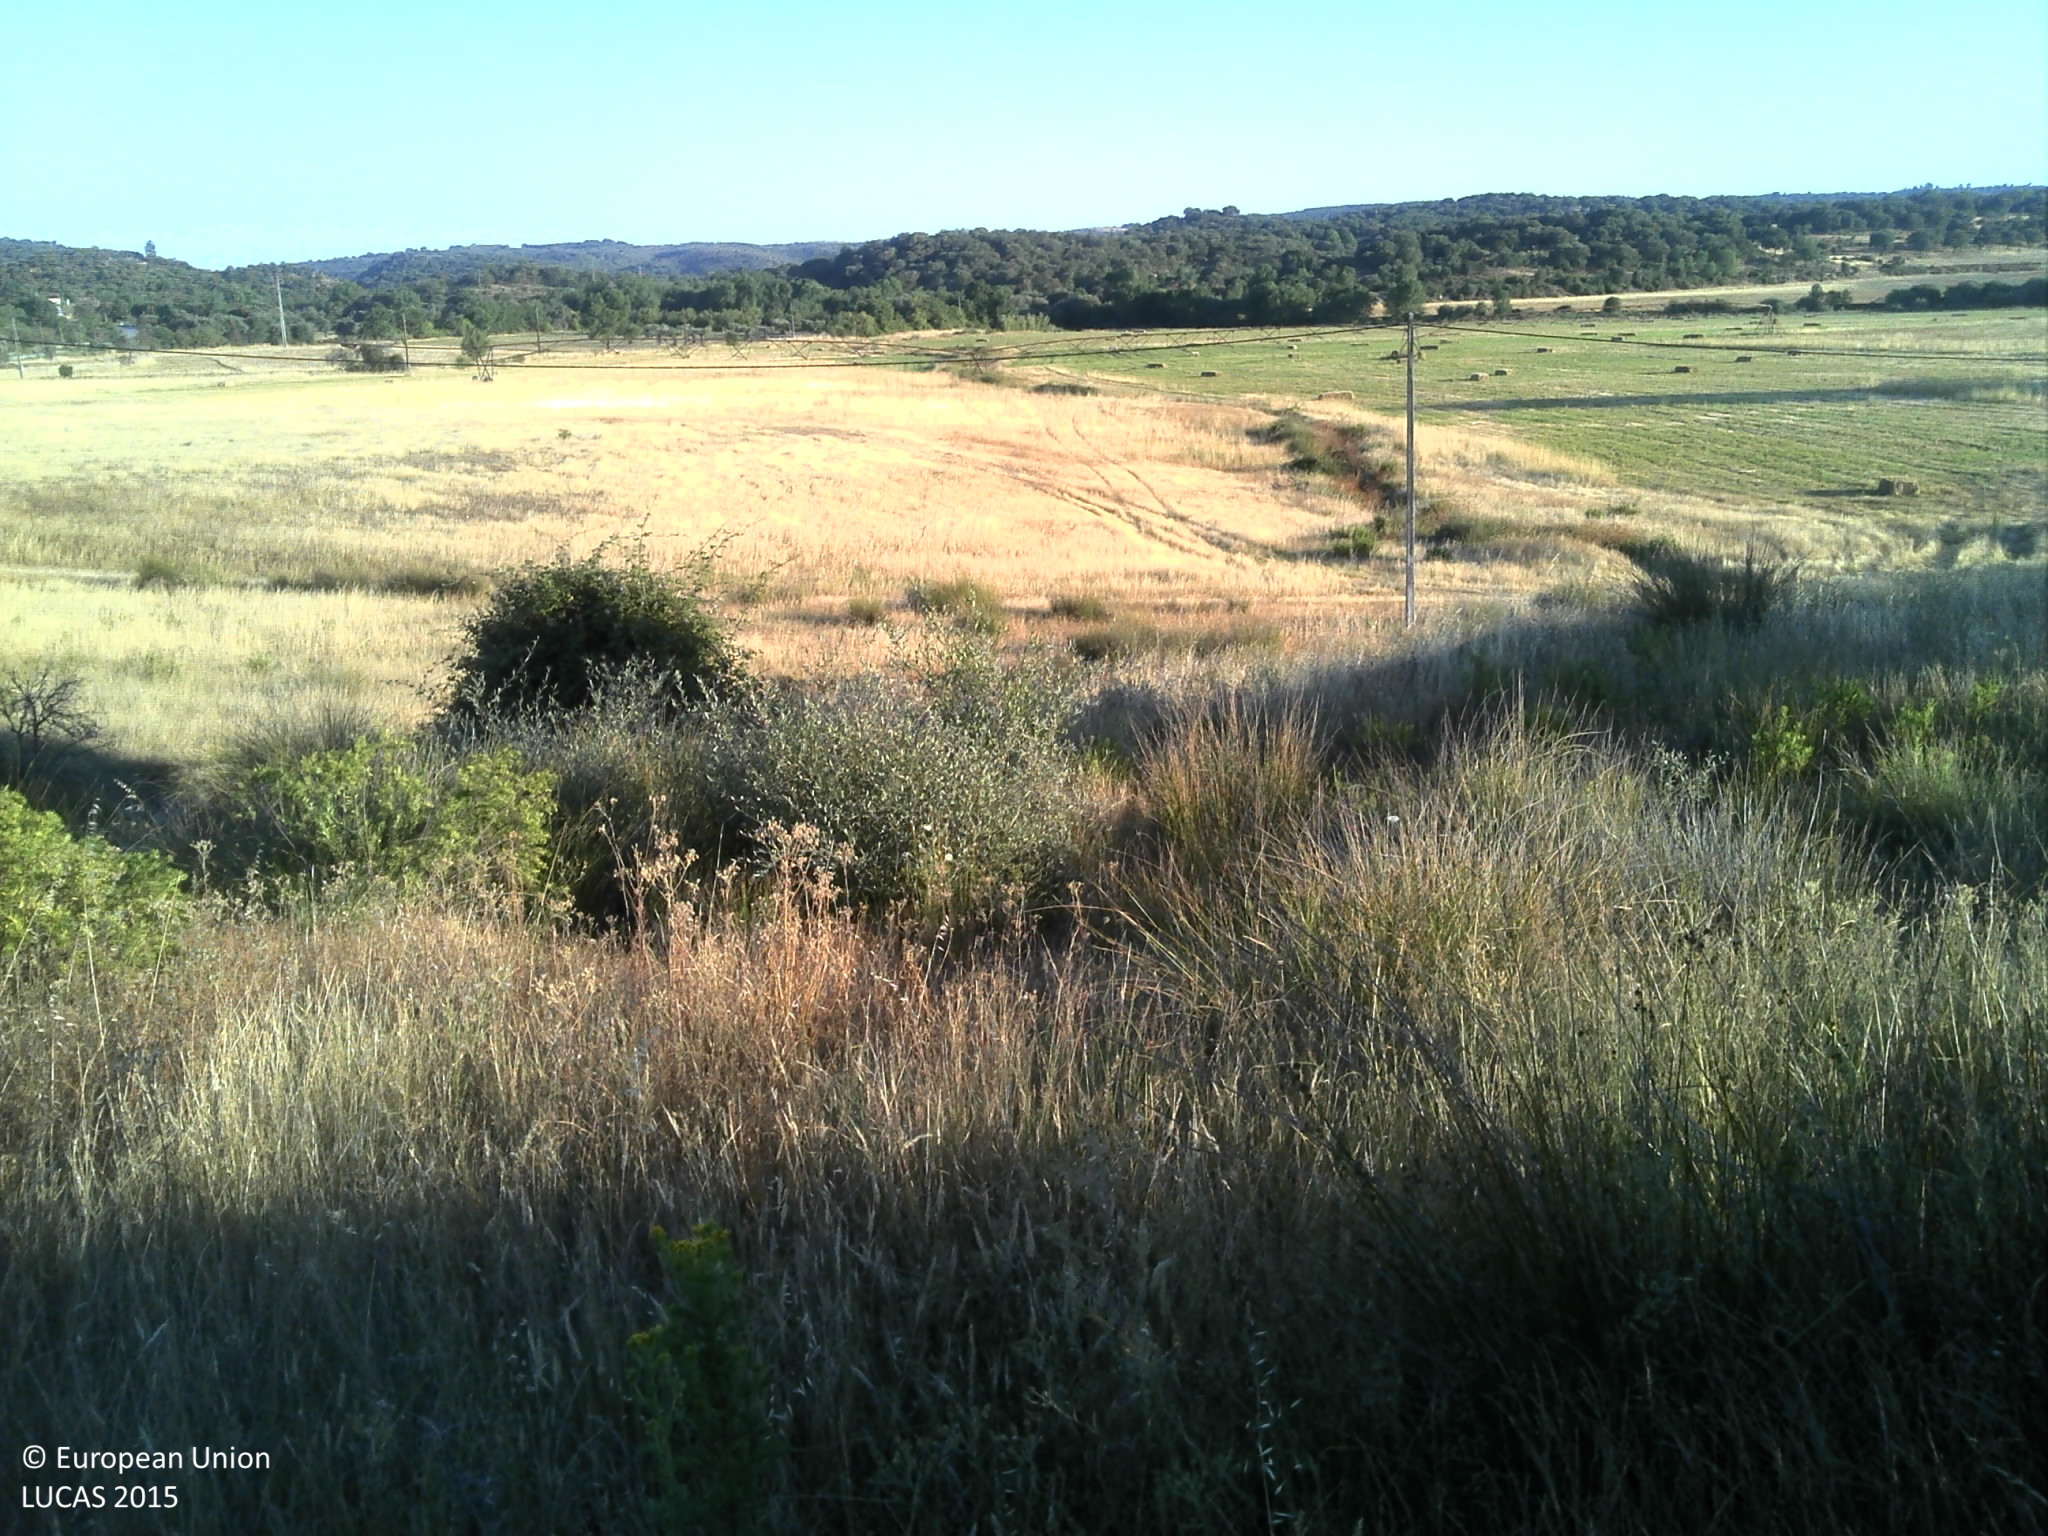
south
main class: Grassland
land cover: Grassland without tree/shrub cover
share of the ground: 50 - 75 %
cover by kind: herbaceous plants 70 %, unconsolidated bare surface 20 %, shrubs 5 %
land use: Agriculture (excluding fallow land and kitchen gardens)
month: June
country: PT
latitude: 39.9819
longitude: -7.3474
